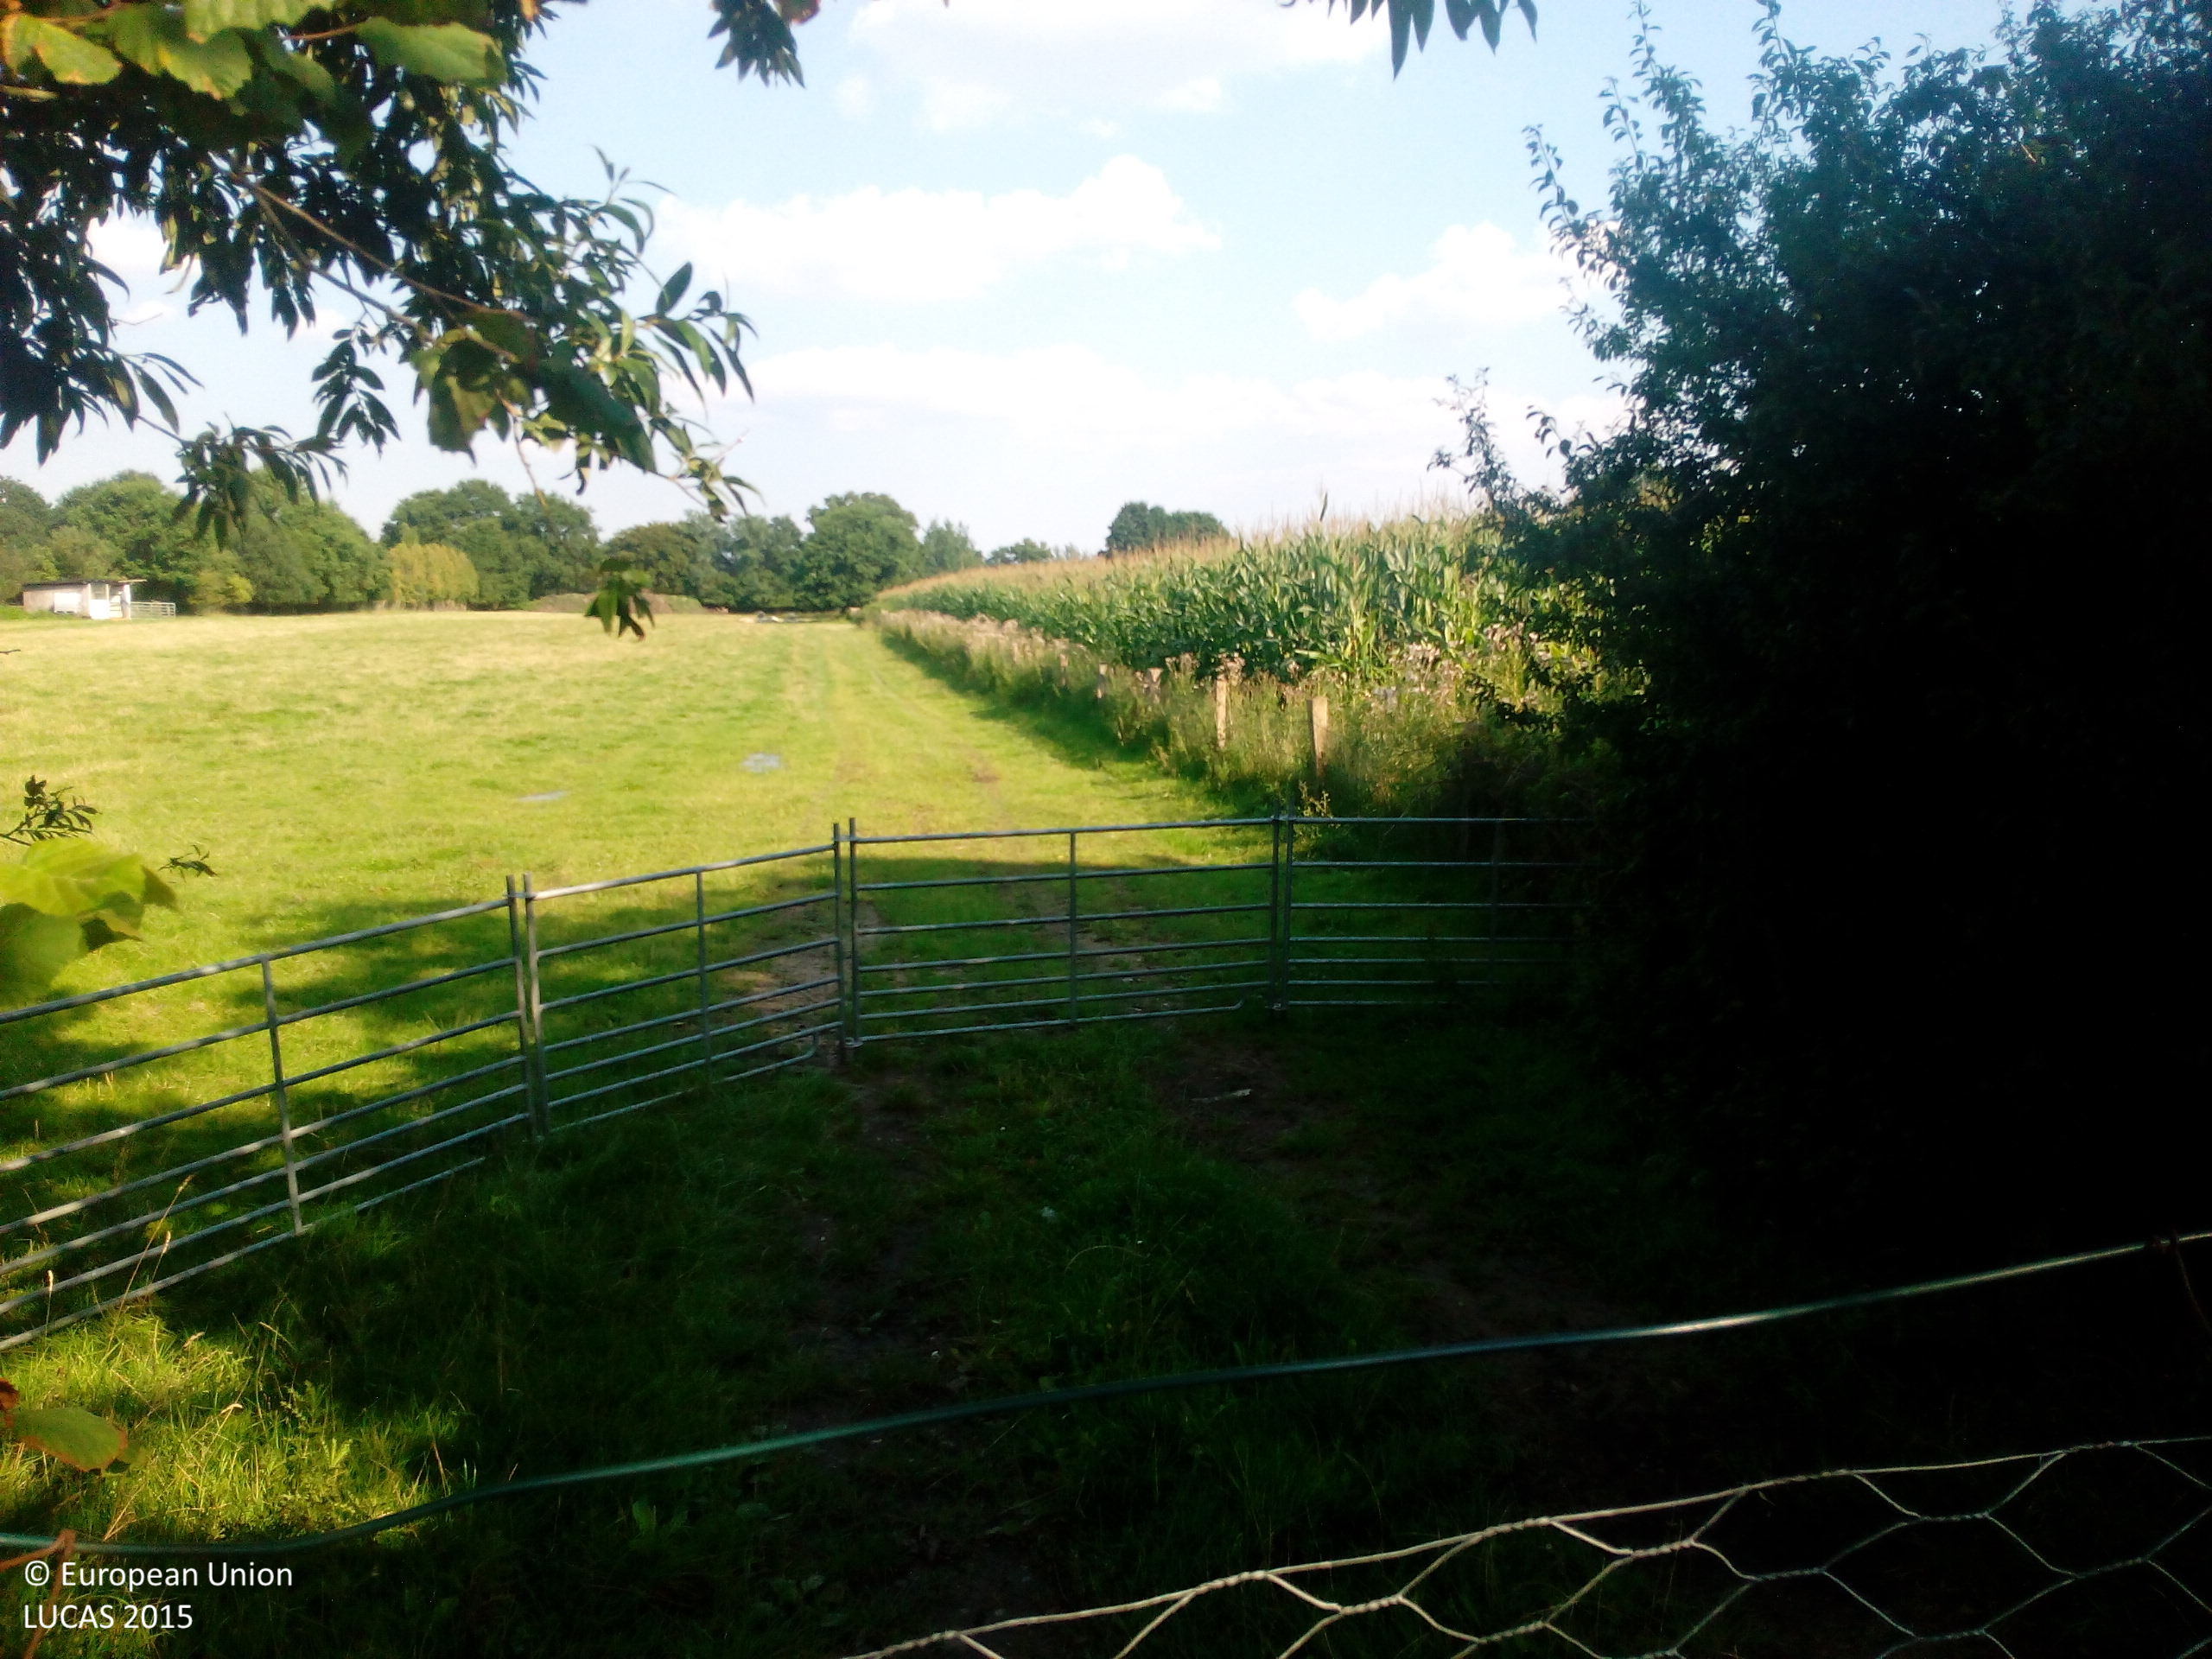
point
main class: Cropland
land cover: Maize
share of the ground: > 75 %
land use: Agriculture (excluding fallow land and kitchen gardens)
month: August
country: DE
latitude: 53.6894
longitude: 9.8638
